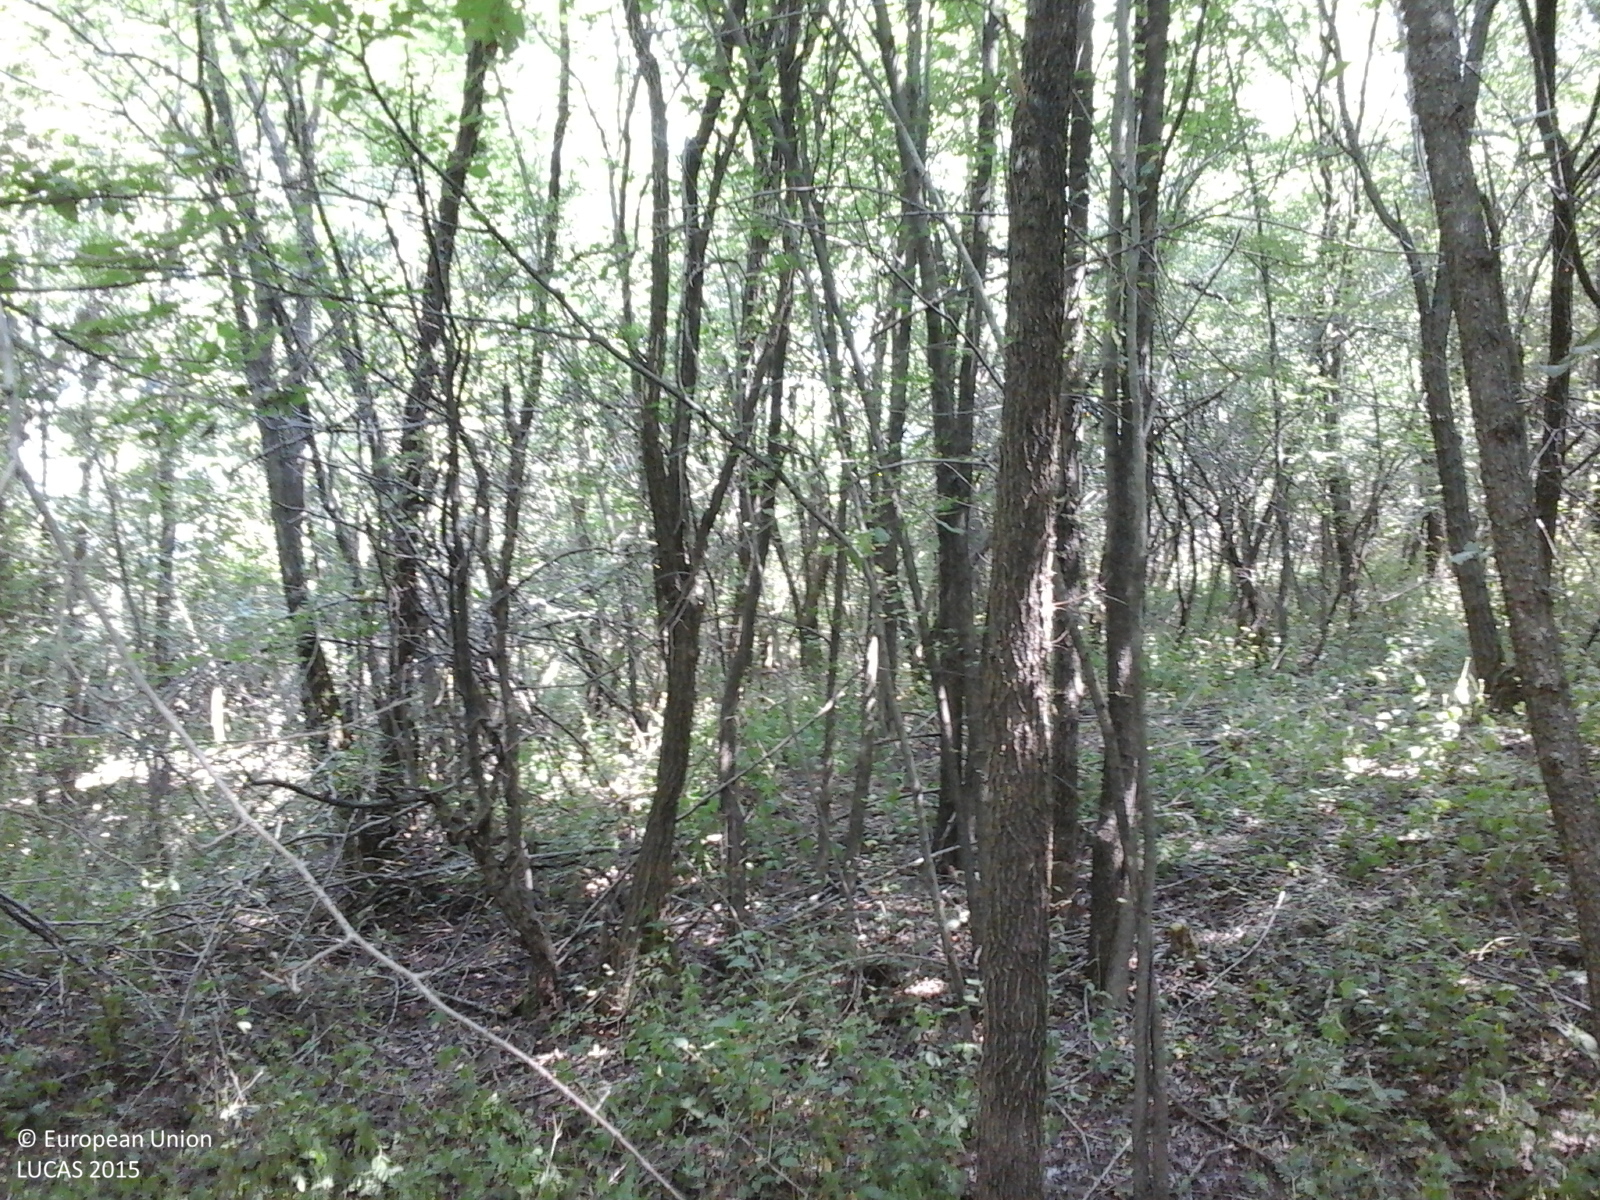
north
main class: Woodland
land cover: Broadleaved woodland
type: non-riverine alder, birch or aspen forest
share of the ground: > 75 %
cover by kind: broadleaved forest trees 100 %
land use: Forestry
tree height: > 5 m
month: July
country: RO
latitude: 44.6811
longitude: 24.6214
